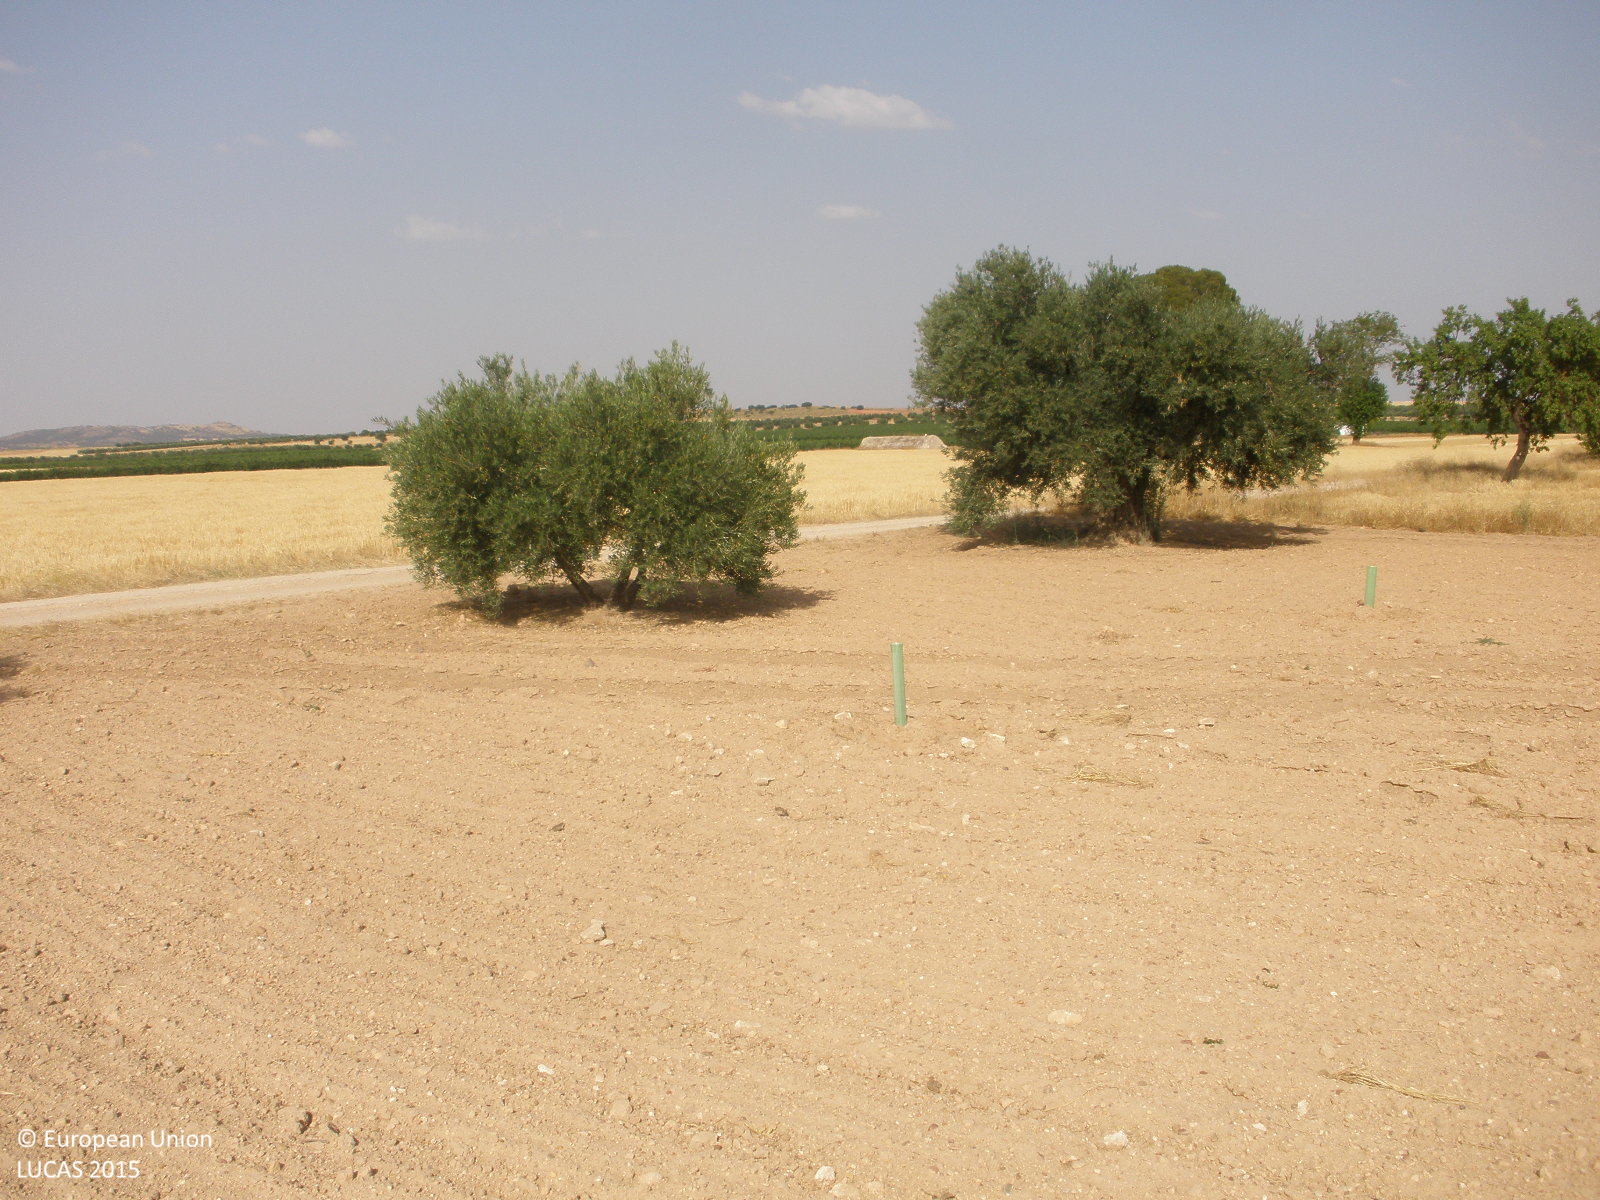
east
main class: Cropland
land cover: Nuts trees
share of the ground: < 10 %
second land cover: Other bare soil
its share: > 75 %
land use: Agriculture (excluding fallow land and kitchen gardens)
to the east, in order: Nuts trees; Other bare soil; Olive groves; Tracks; Barley; Grass margins; Barley; Grass margins; Vineyards
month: July
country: ES
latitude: 39.7074
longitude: -3.2846
